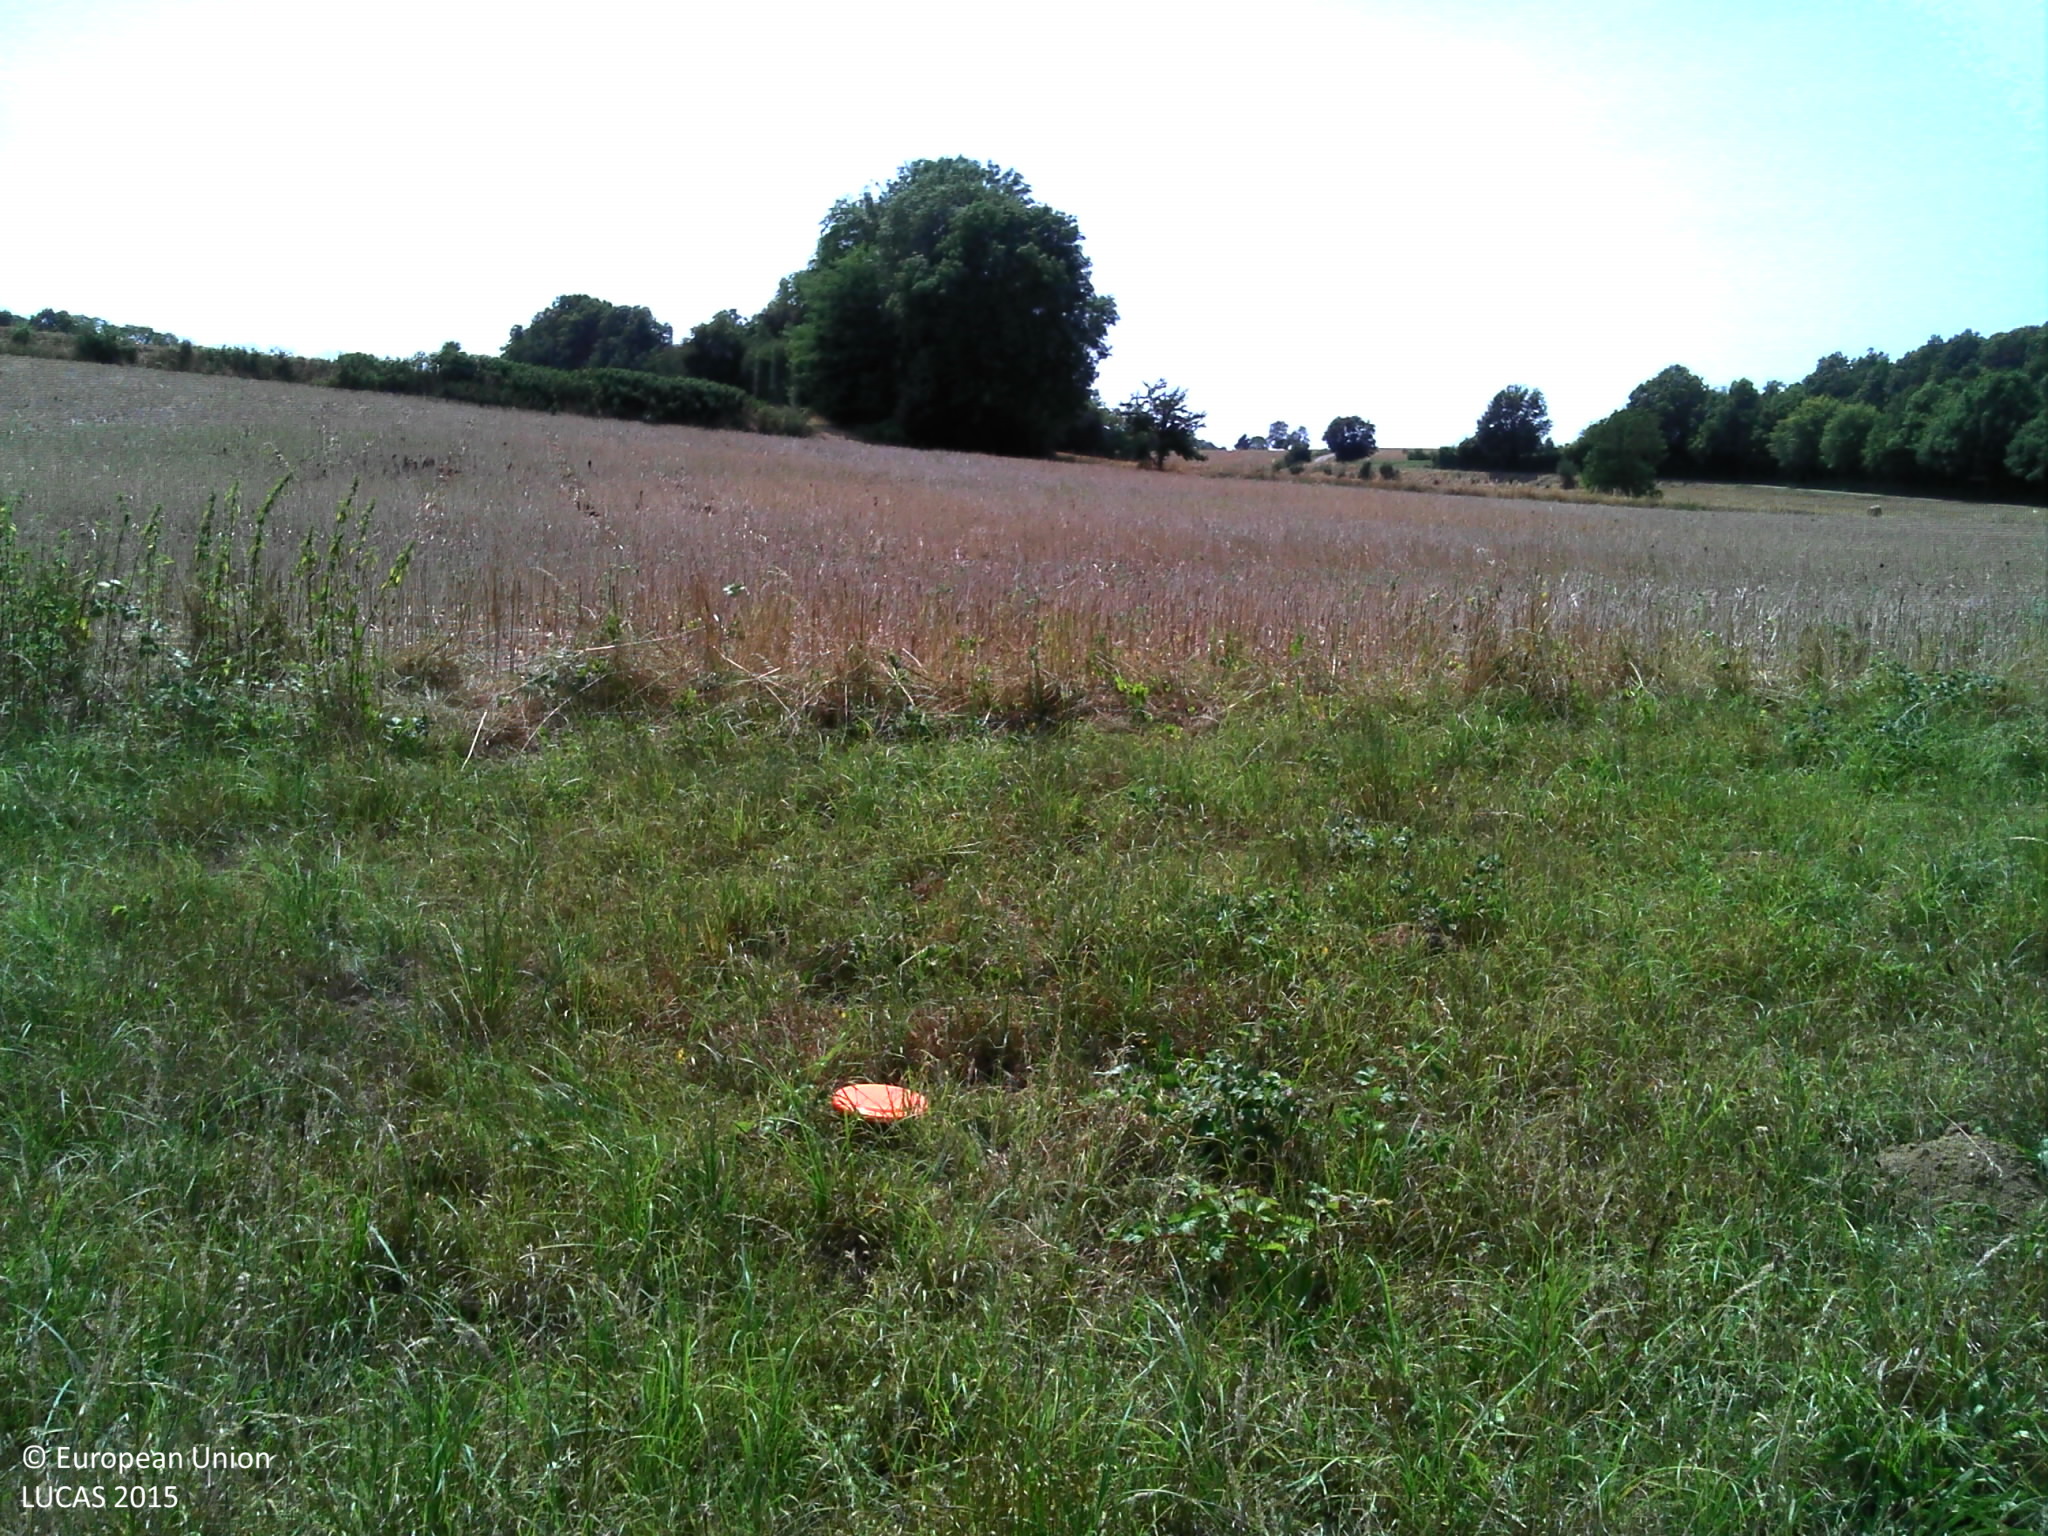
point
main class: Grassland
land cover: Grassland without tree/shrub cover
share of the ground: > 75 %
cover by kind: herbaceous plants 100 %
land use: Agriculture (excluding fallow land and kitchen gardens)
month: August
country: FR
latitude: 47.8113
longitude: 3.1434
